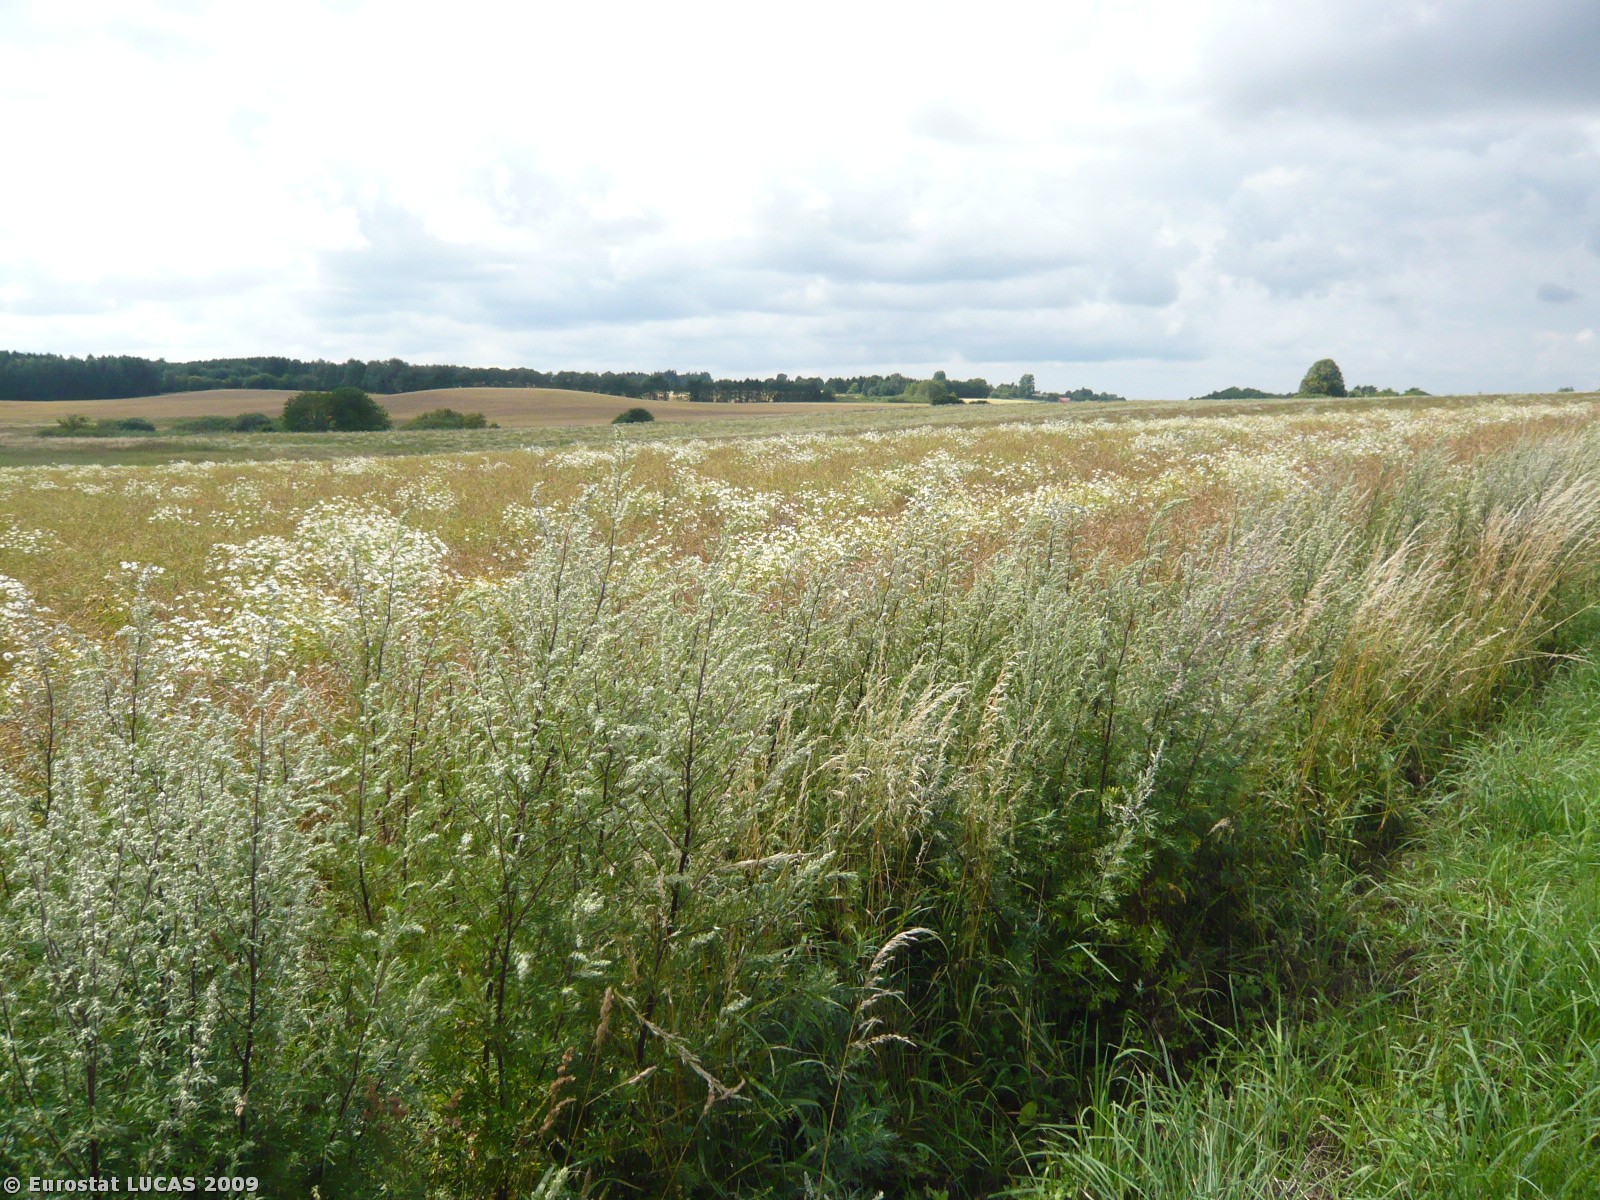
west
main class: Cropland
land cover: Rape and turnip rape
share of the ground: > 75 %
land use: Agriculture (excluding fallow land and kitchen gardens)
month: July
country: DK
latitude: 55.5092
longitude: 11.8511
